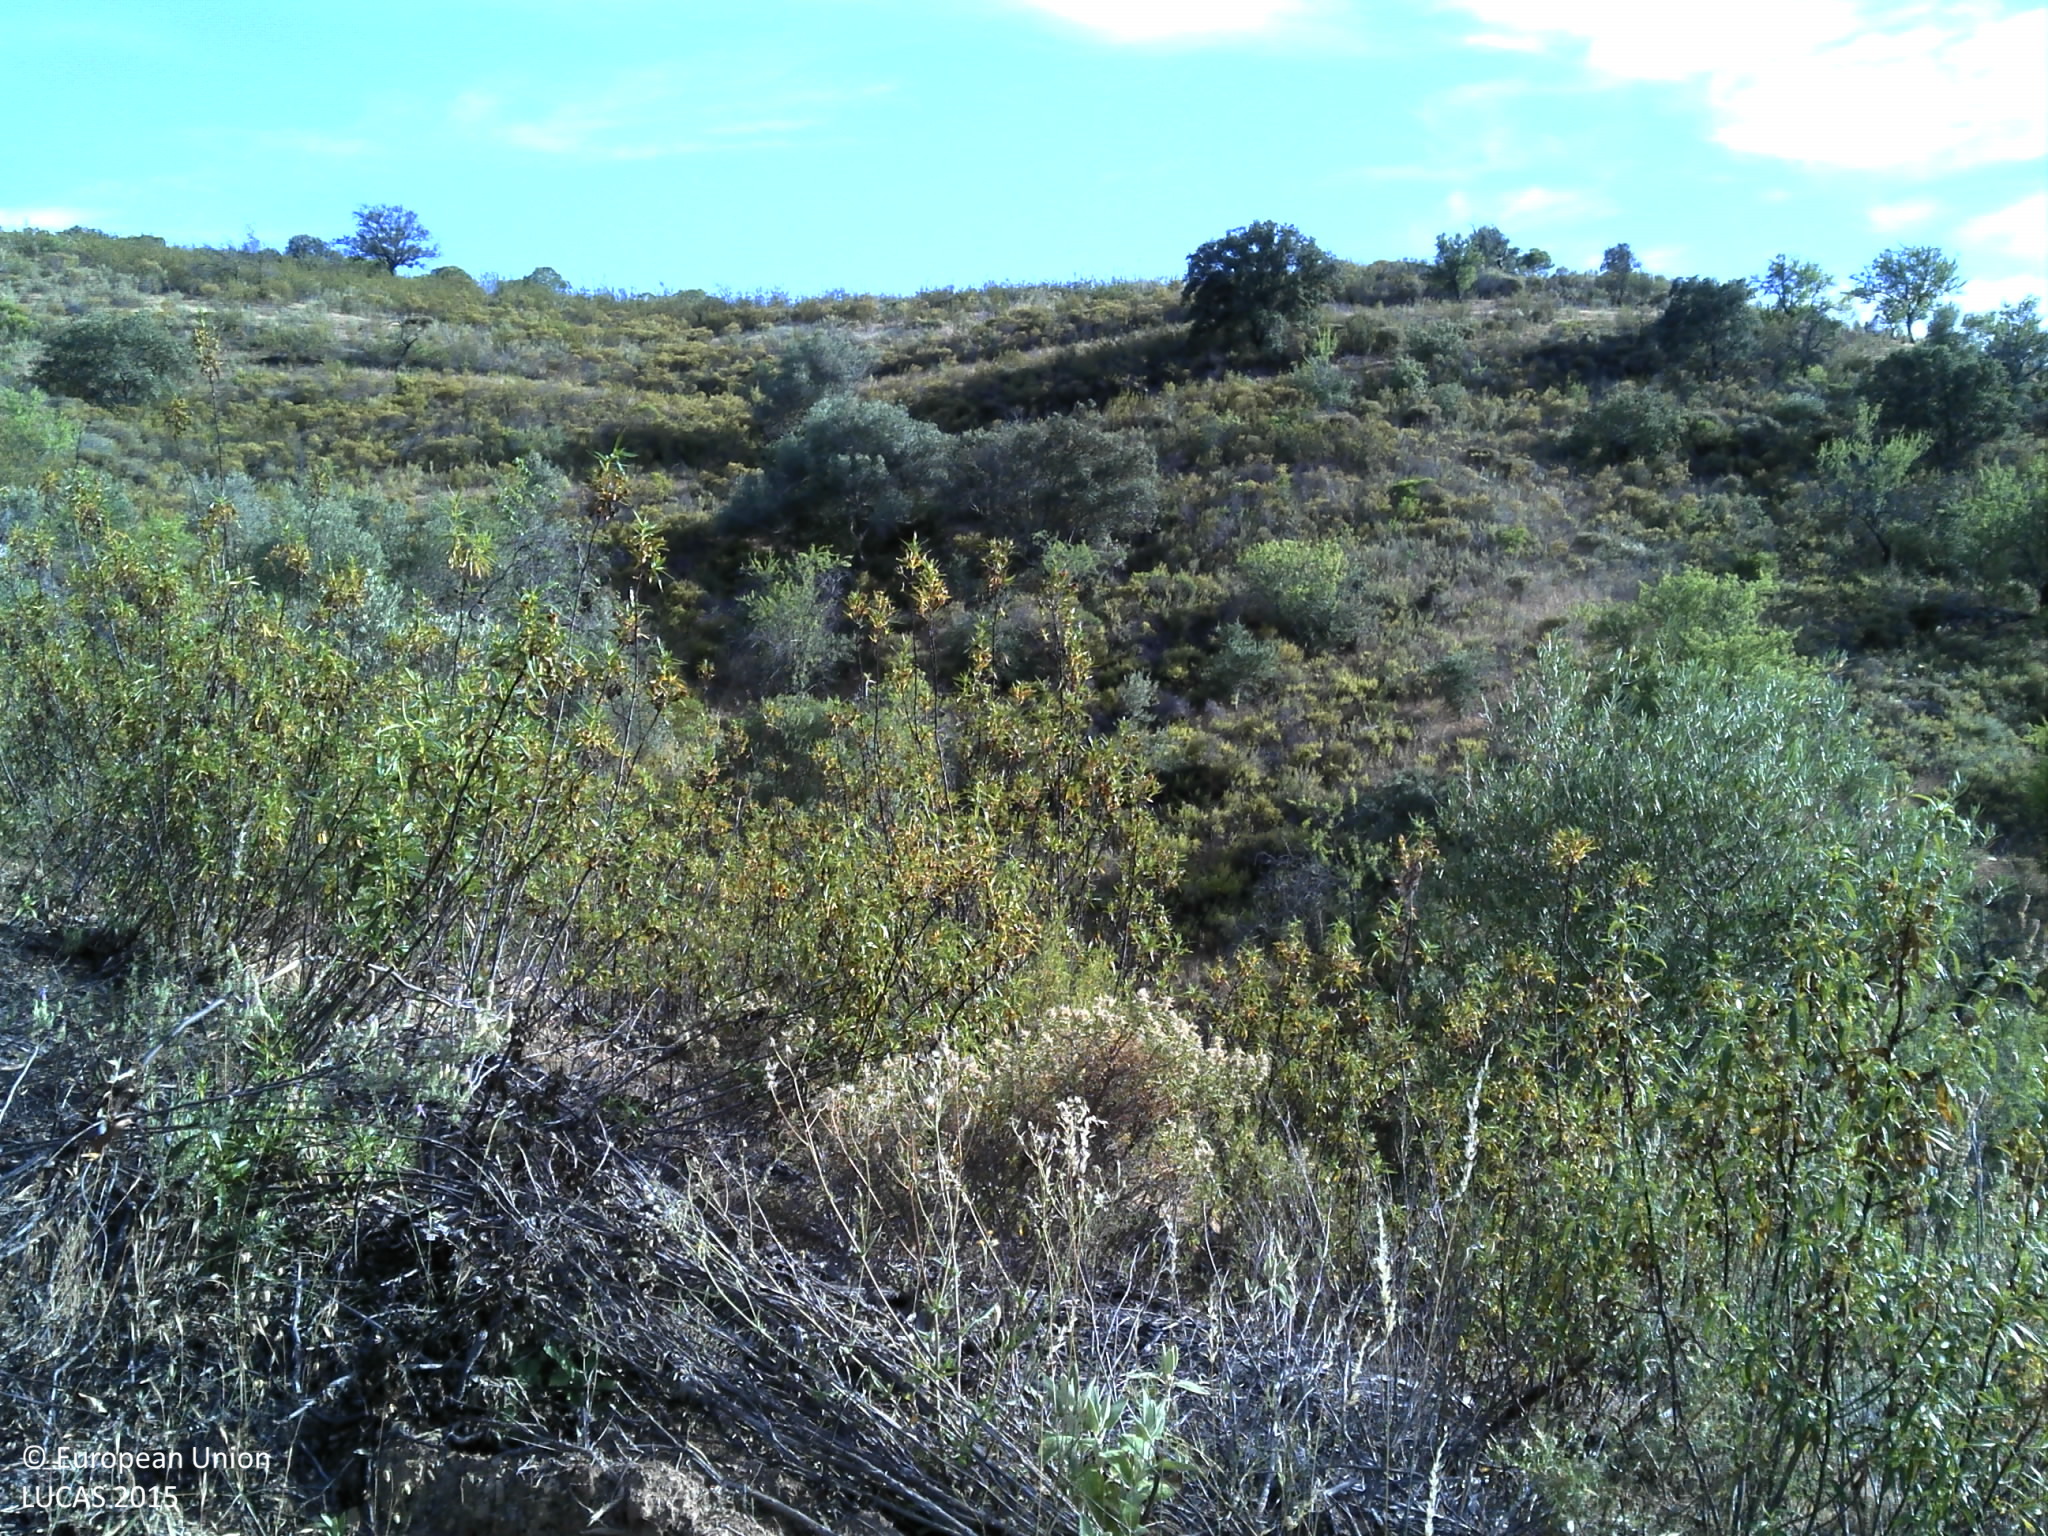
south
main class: Shrubland
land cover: Shrubland with sparse tree cover
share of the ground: 50 - 75 %
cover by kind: shrubs 75 %, unconsolidated bare surface 20 %, broadleaved forest trees 5 %
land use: Abandoned areas
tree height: > 5 m
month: May
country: PT
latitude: 37.2987
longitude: -7.4794
